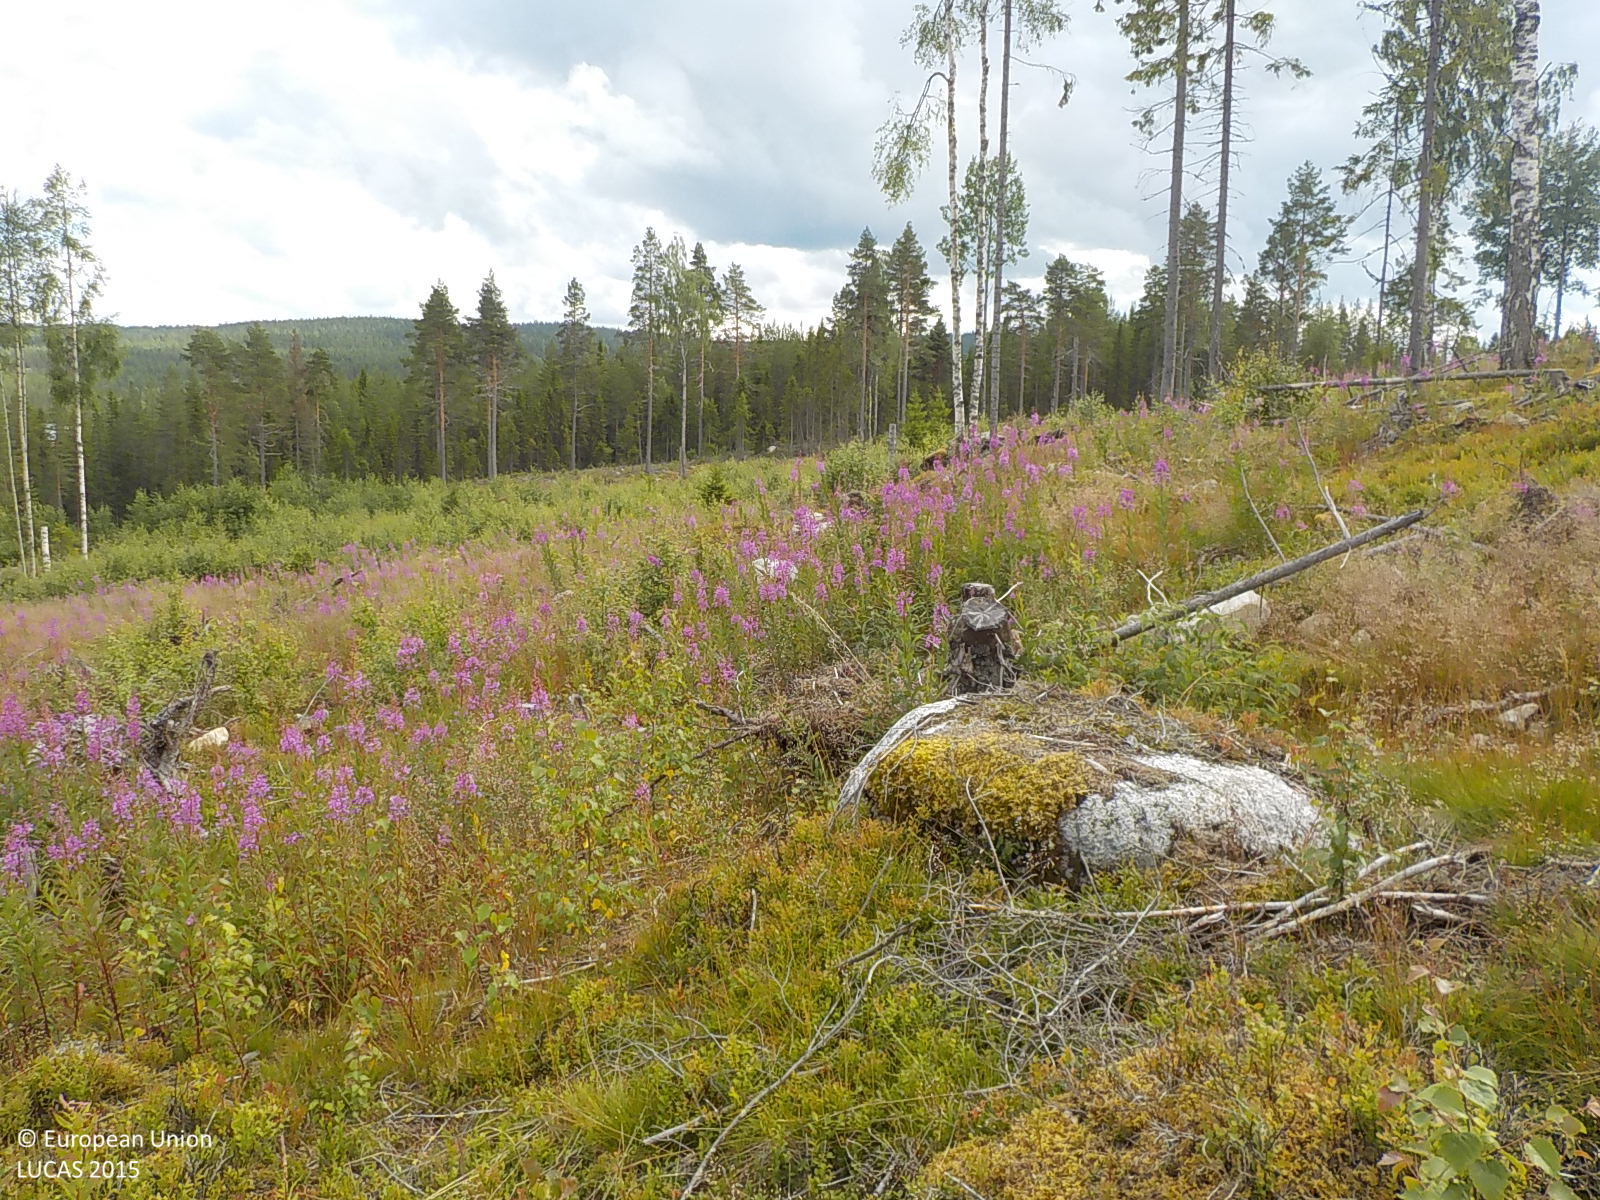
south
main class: Woodland
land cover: Broadleaved woodland
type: boreal forest
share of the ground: 50 - 75 %
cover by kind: broadleaved forest trees 50 %, herbaceous plants 45 %, shrubs 5 %
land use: Forestry
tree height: < 5 m
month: July
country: SE
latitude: 63.2657
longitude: 17.3675
